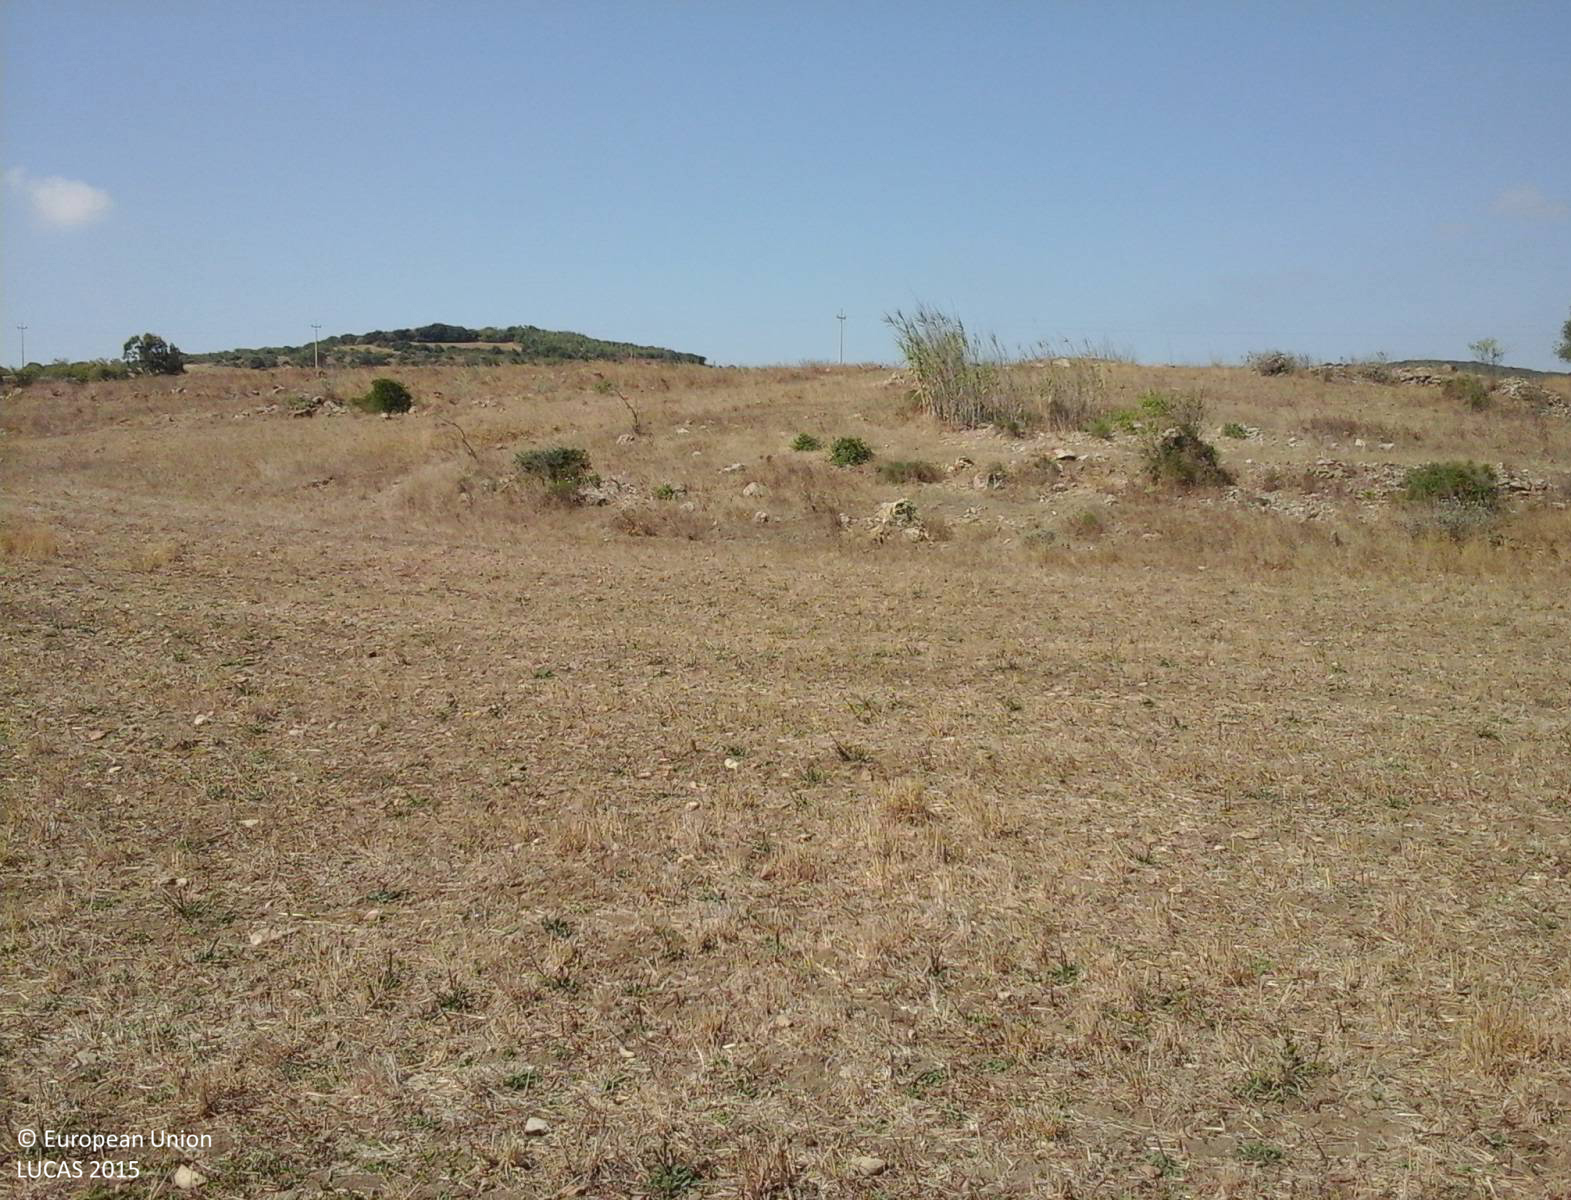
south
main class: Grassland
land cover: Spontaneously vegetated surfaces
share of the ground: > 75 %
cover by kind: herbaceous plants 100 %
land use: Agriculture (excluding fallow land and kitchen gardens)
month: July
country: IT
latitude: 39.6452
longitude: 8.8762
